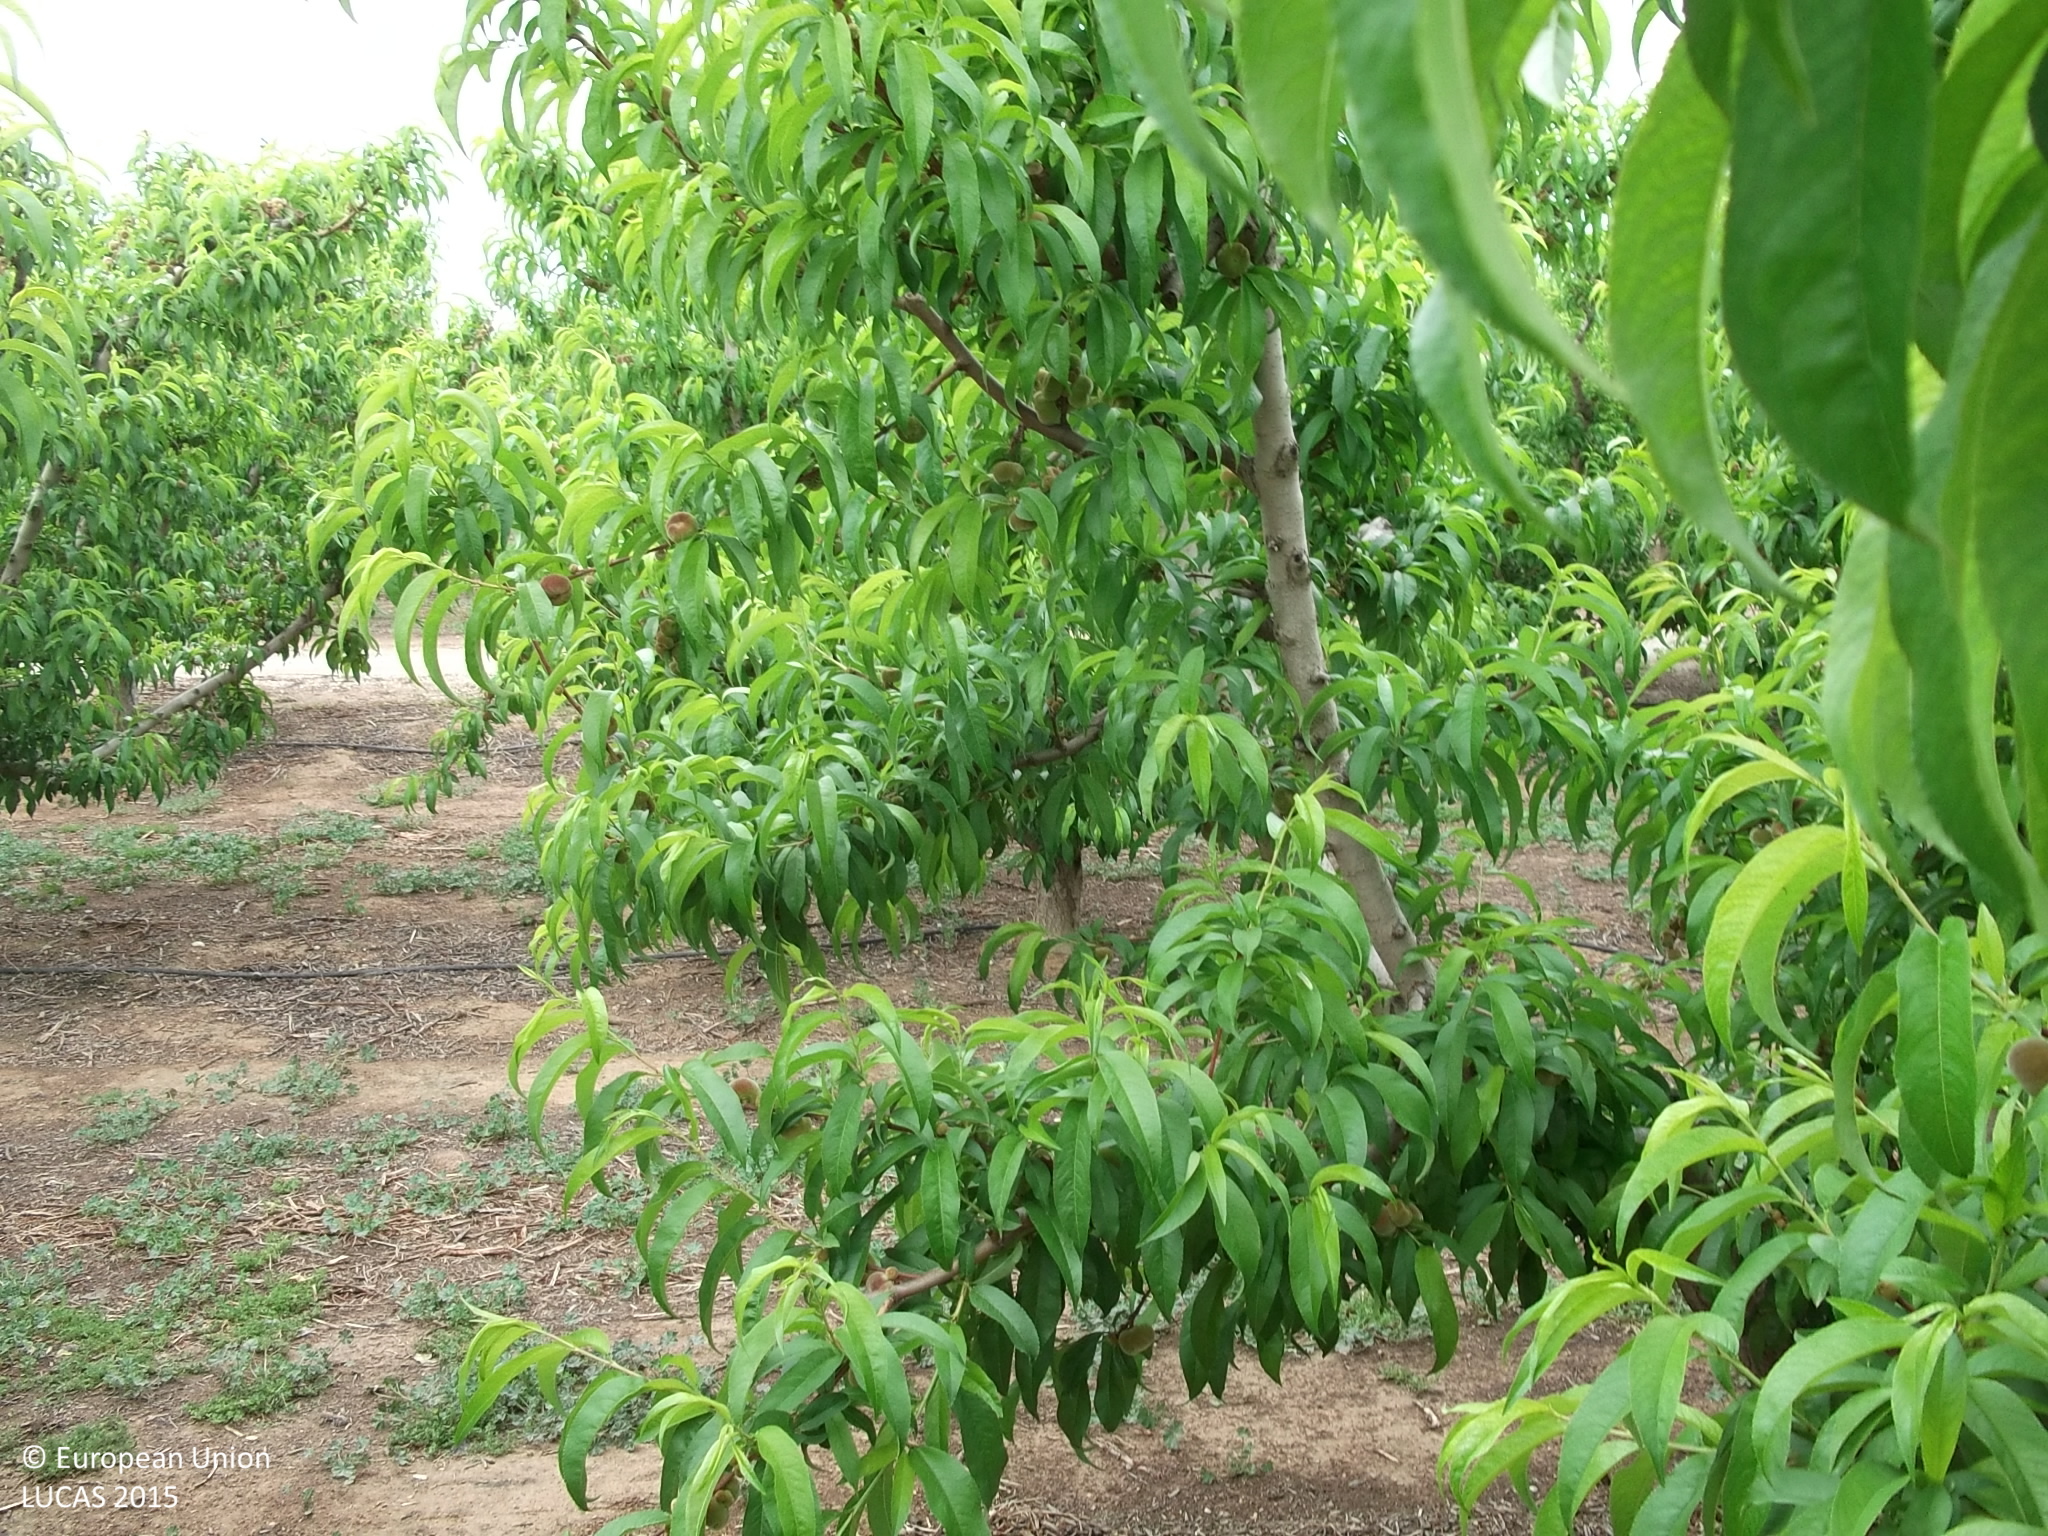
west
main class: Cropland
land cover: Other fruit trees and berries
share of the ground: 25 - 50 %
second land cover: Spontaneously vegetated surfaces
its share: 50 - 75 %
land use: Agriculture (excluding fallow land and kitchen gardens)
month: April
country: ES
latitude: 38.2204
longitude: -1.3300
